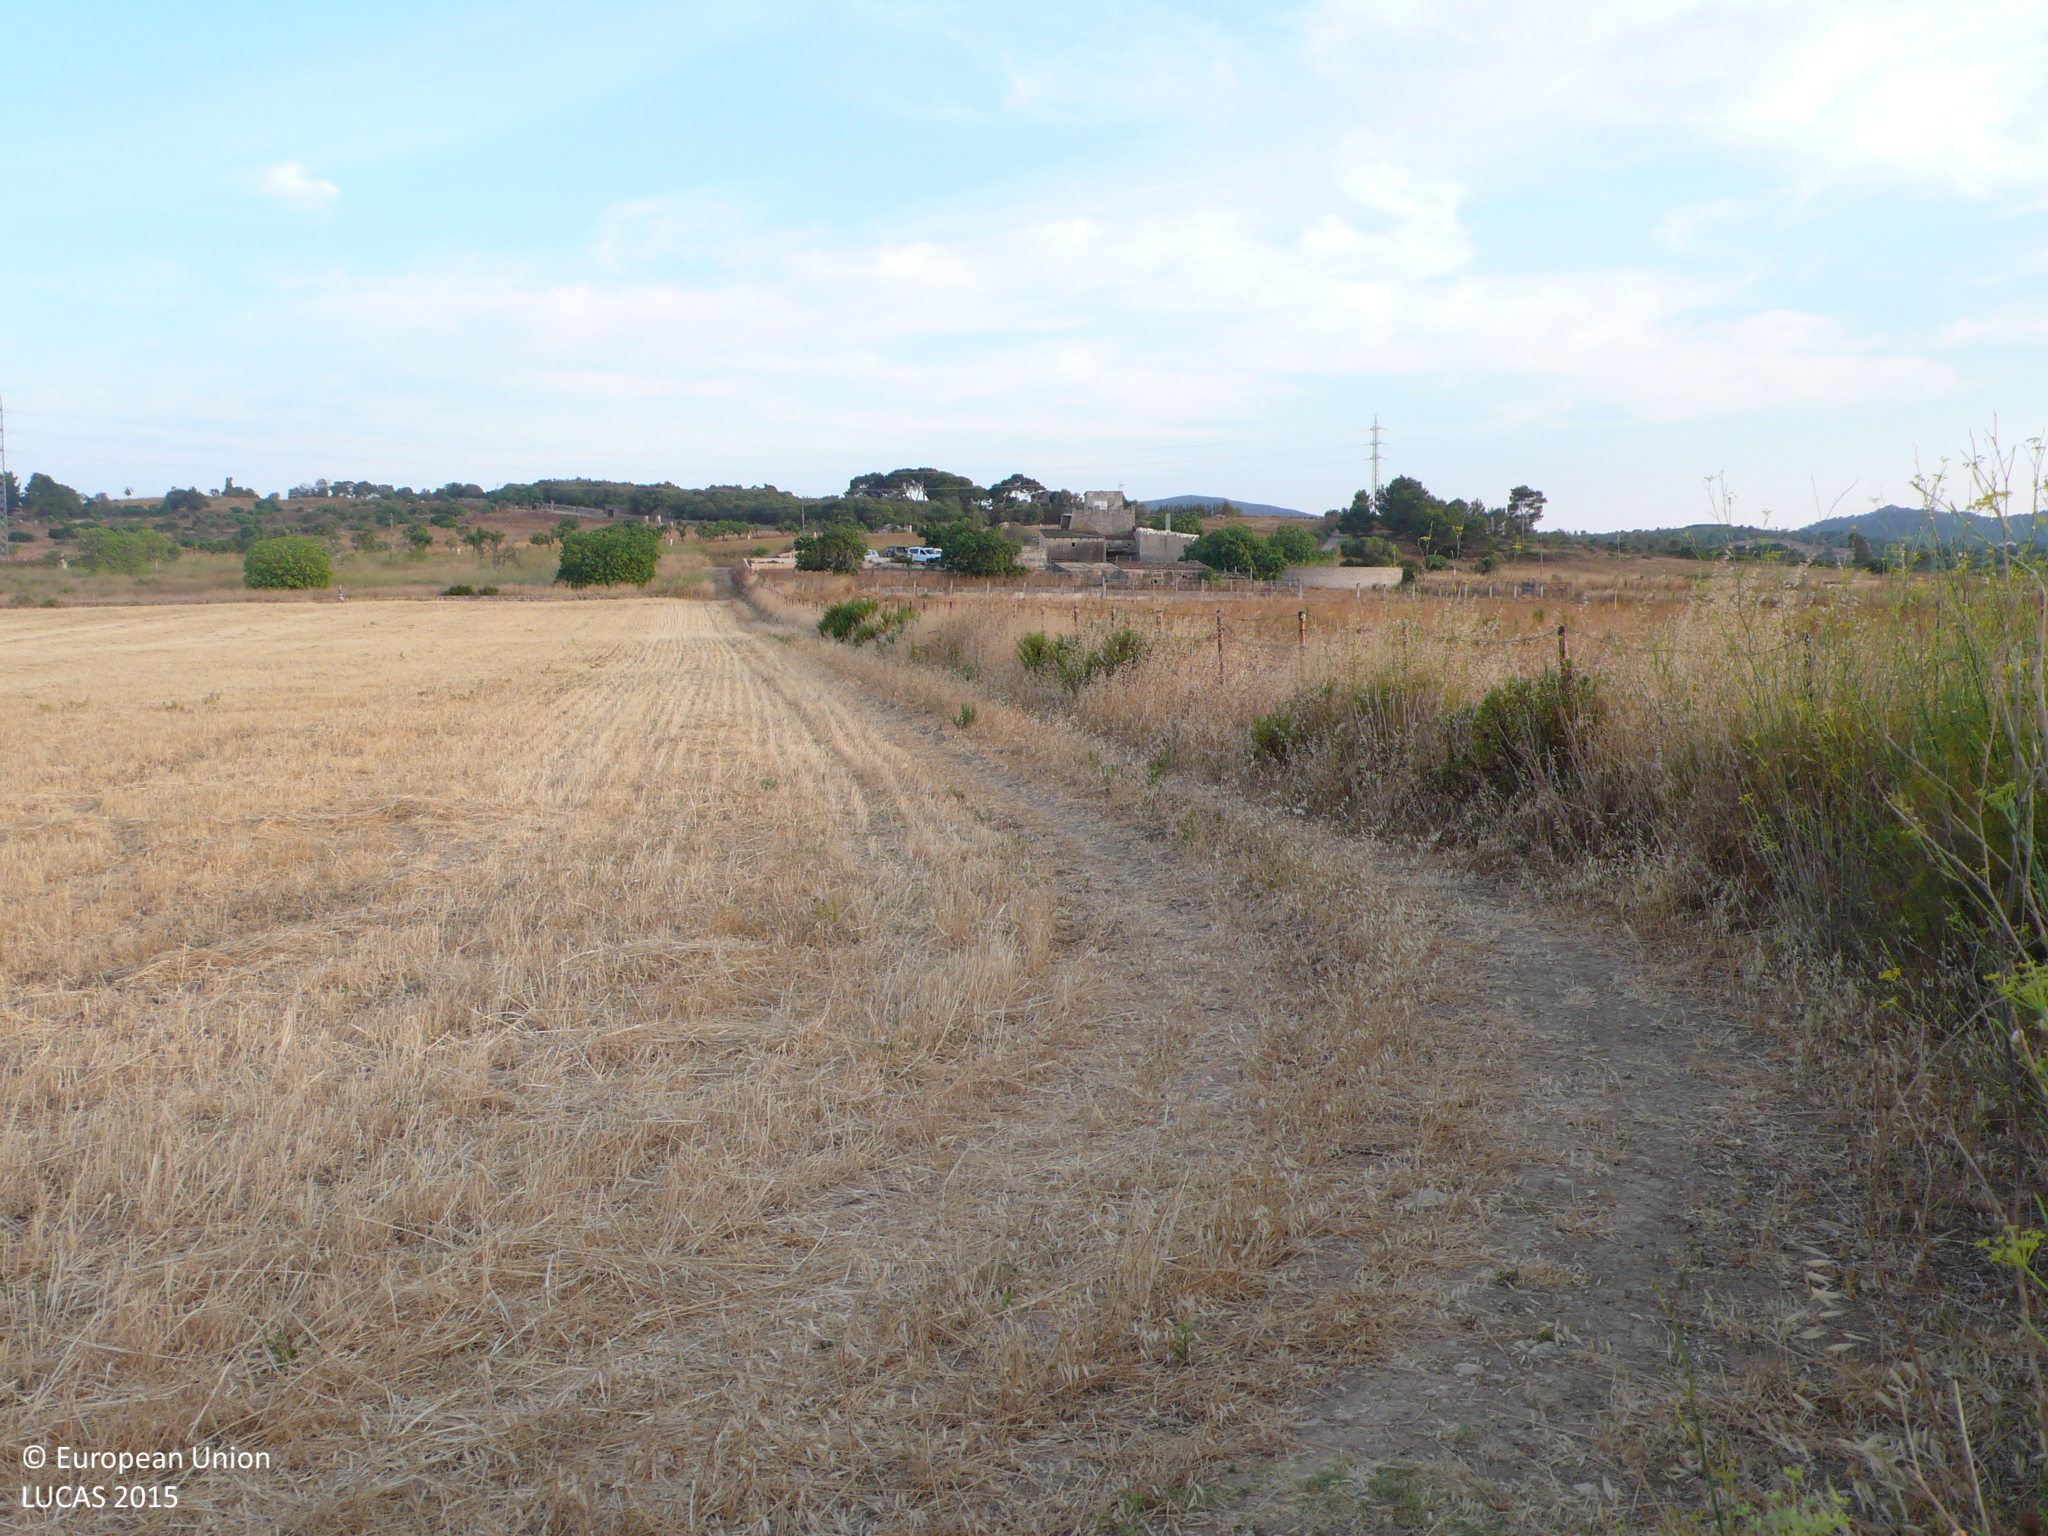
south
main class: Cropland
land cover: Mixed cereals for fodder
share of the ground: > 75 %
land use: Agriculture (excluding fallow land and kitchen gardens)
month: July
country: ES
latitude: 39.5637
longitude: 3.2673
